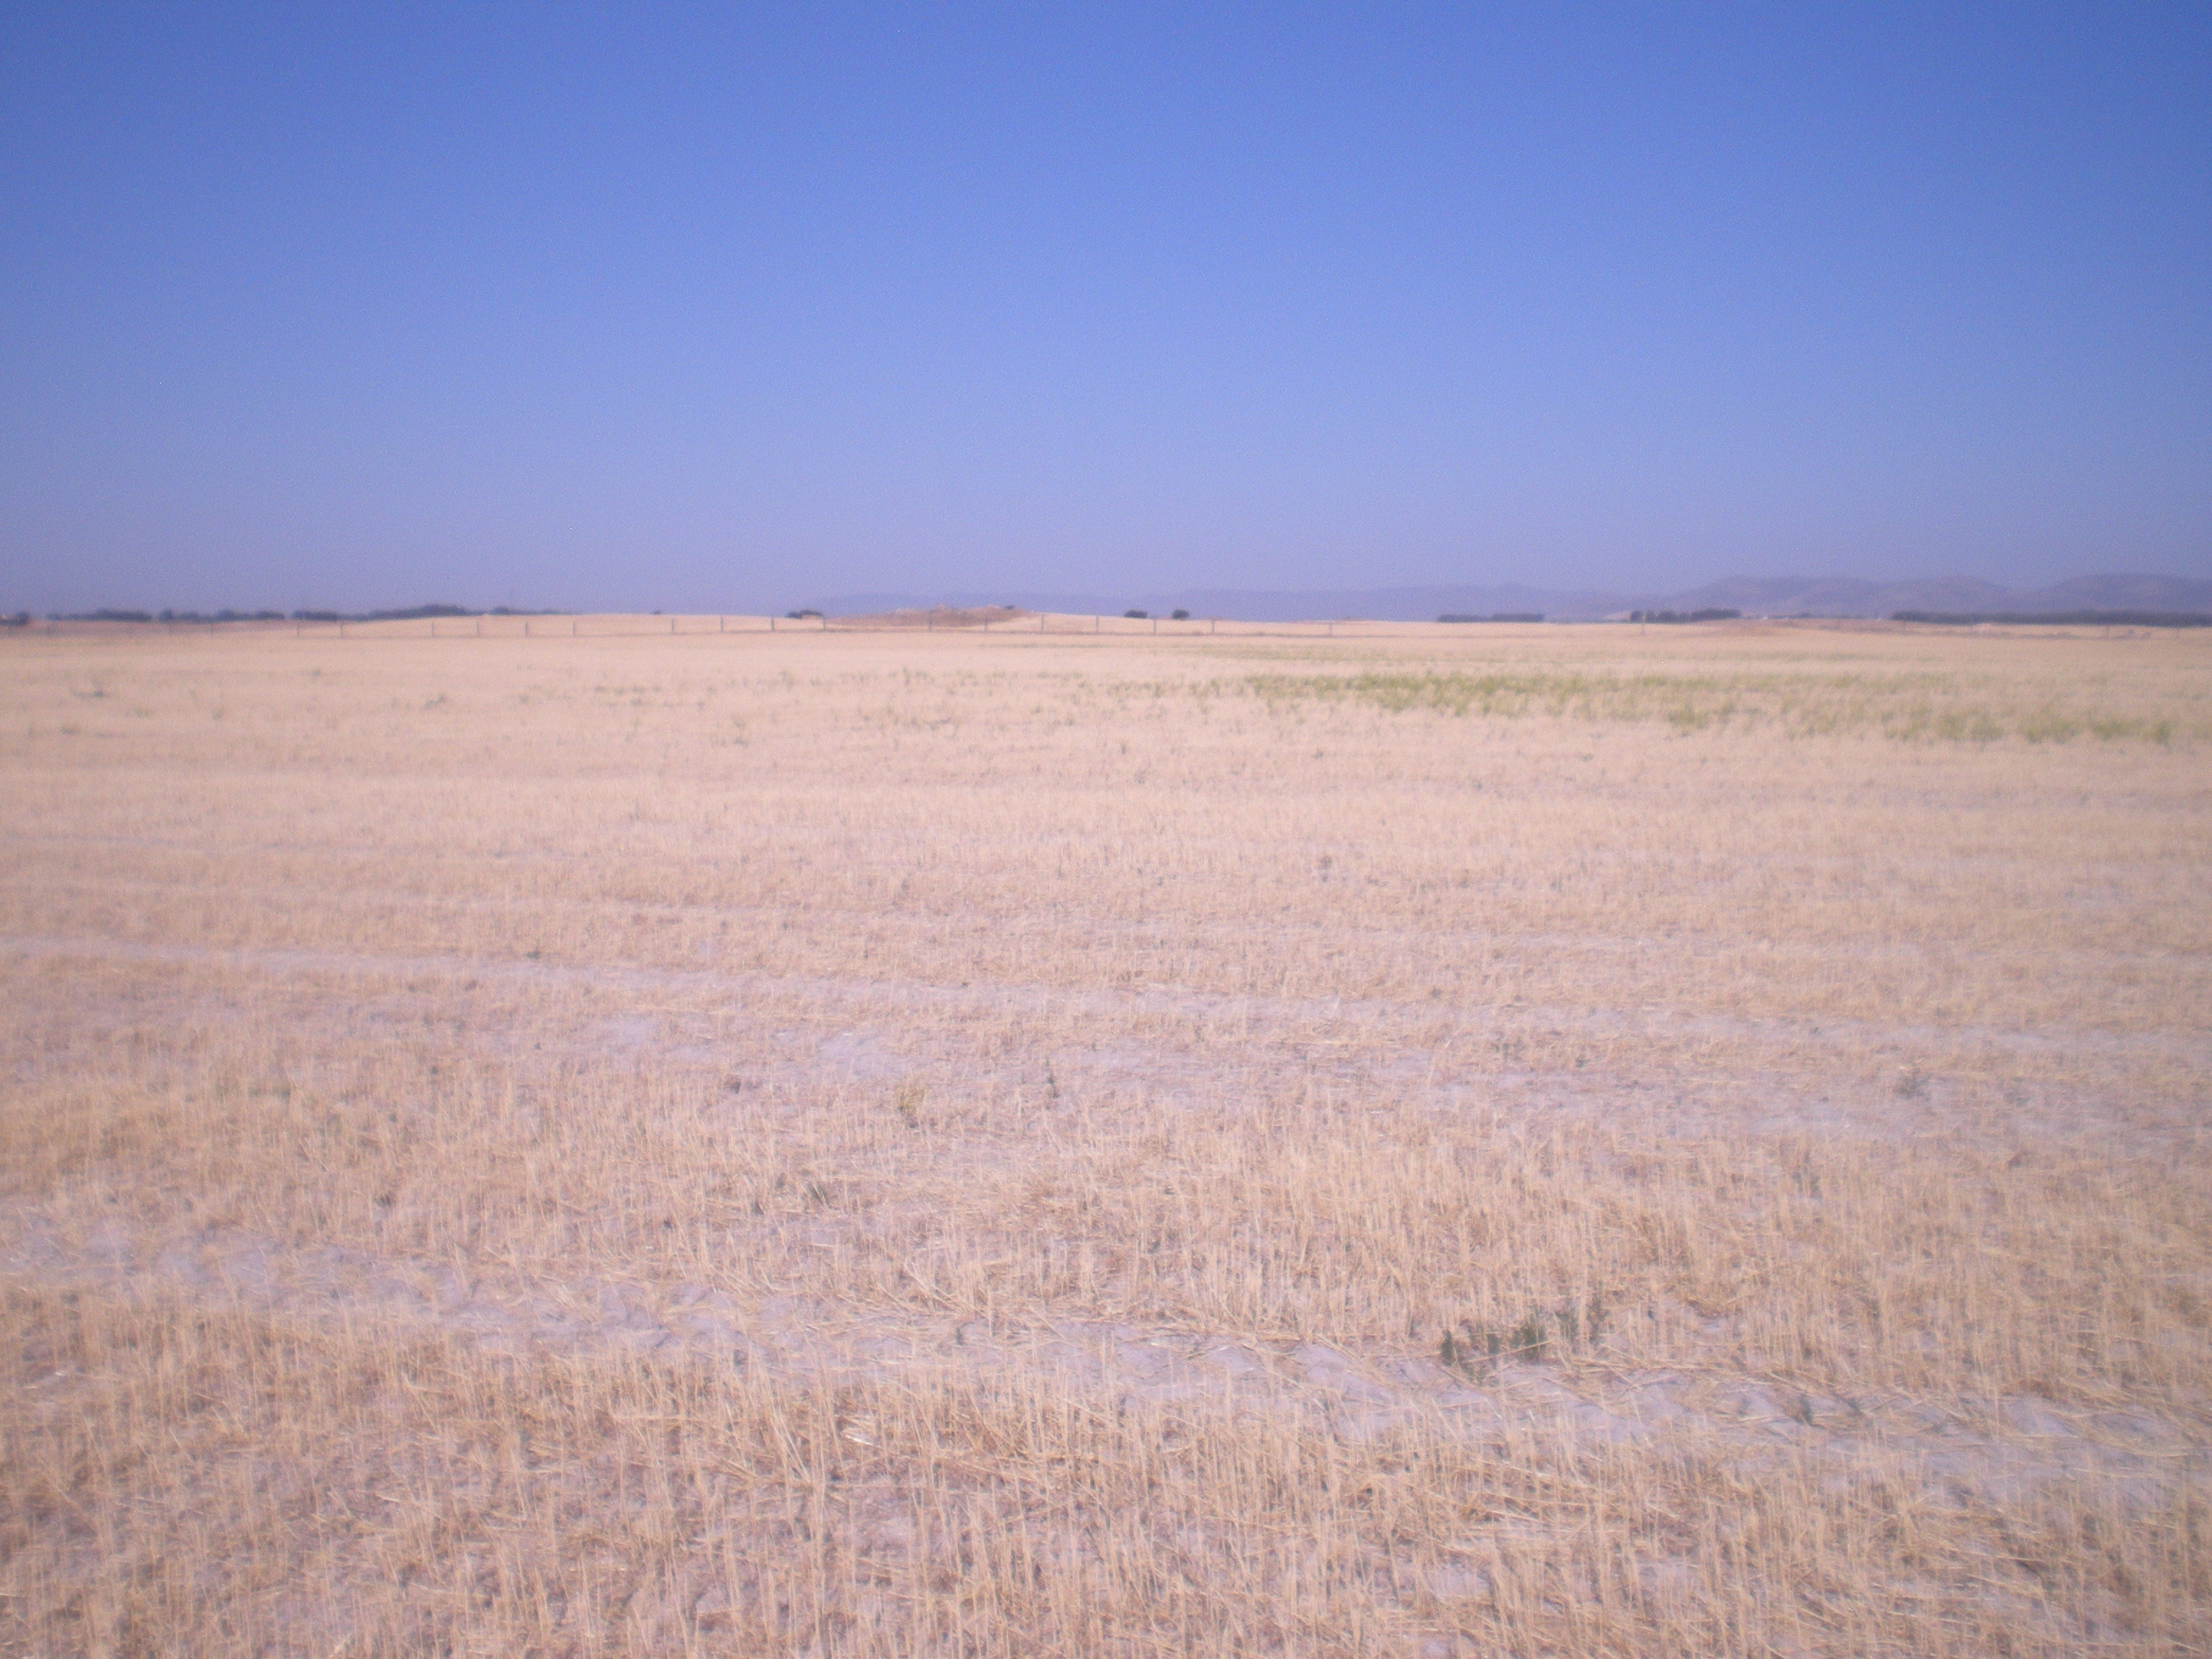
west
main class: Cropland
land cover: Barley
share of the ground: < 10 %
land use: Agriculture (excluding fallow land and kitchen gardens)
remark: Harvested field
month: July
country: ES
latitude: 39.2884
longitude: -3.2689
